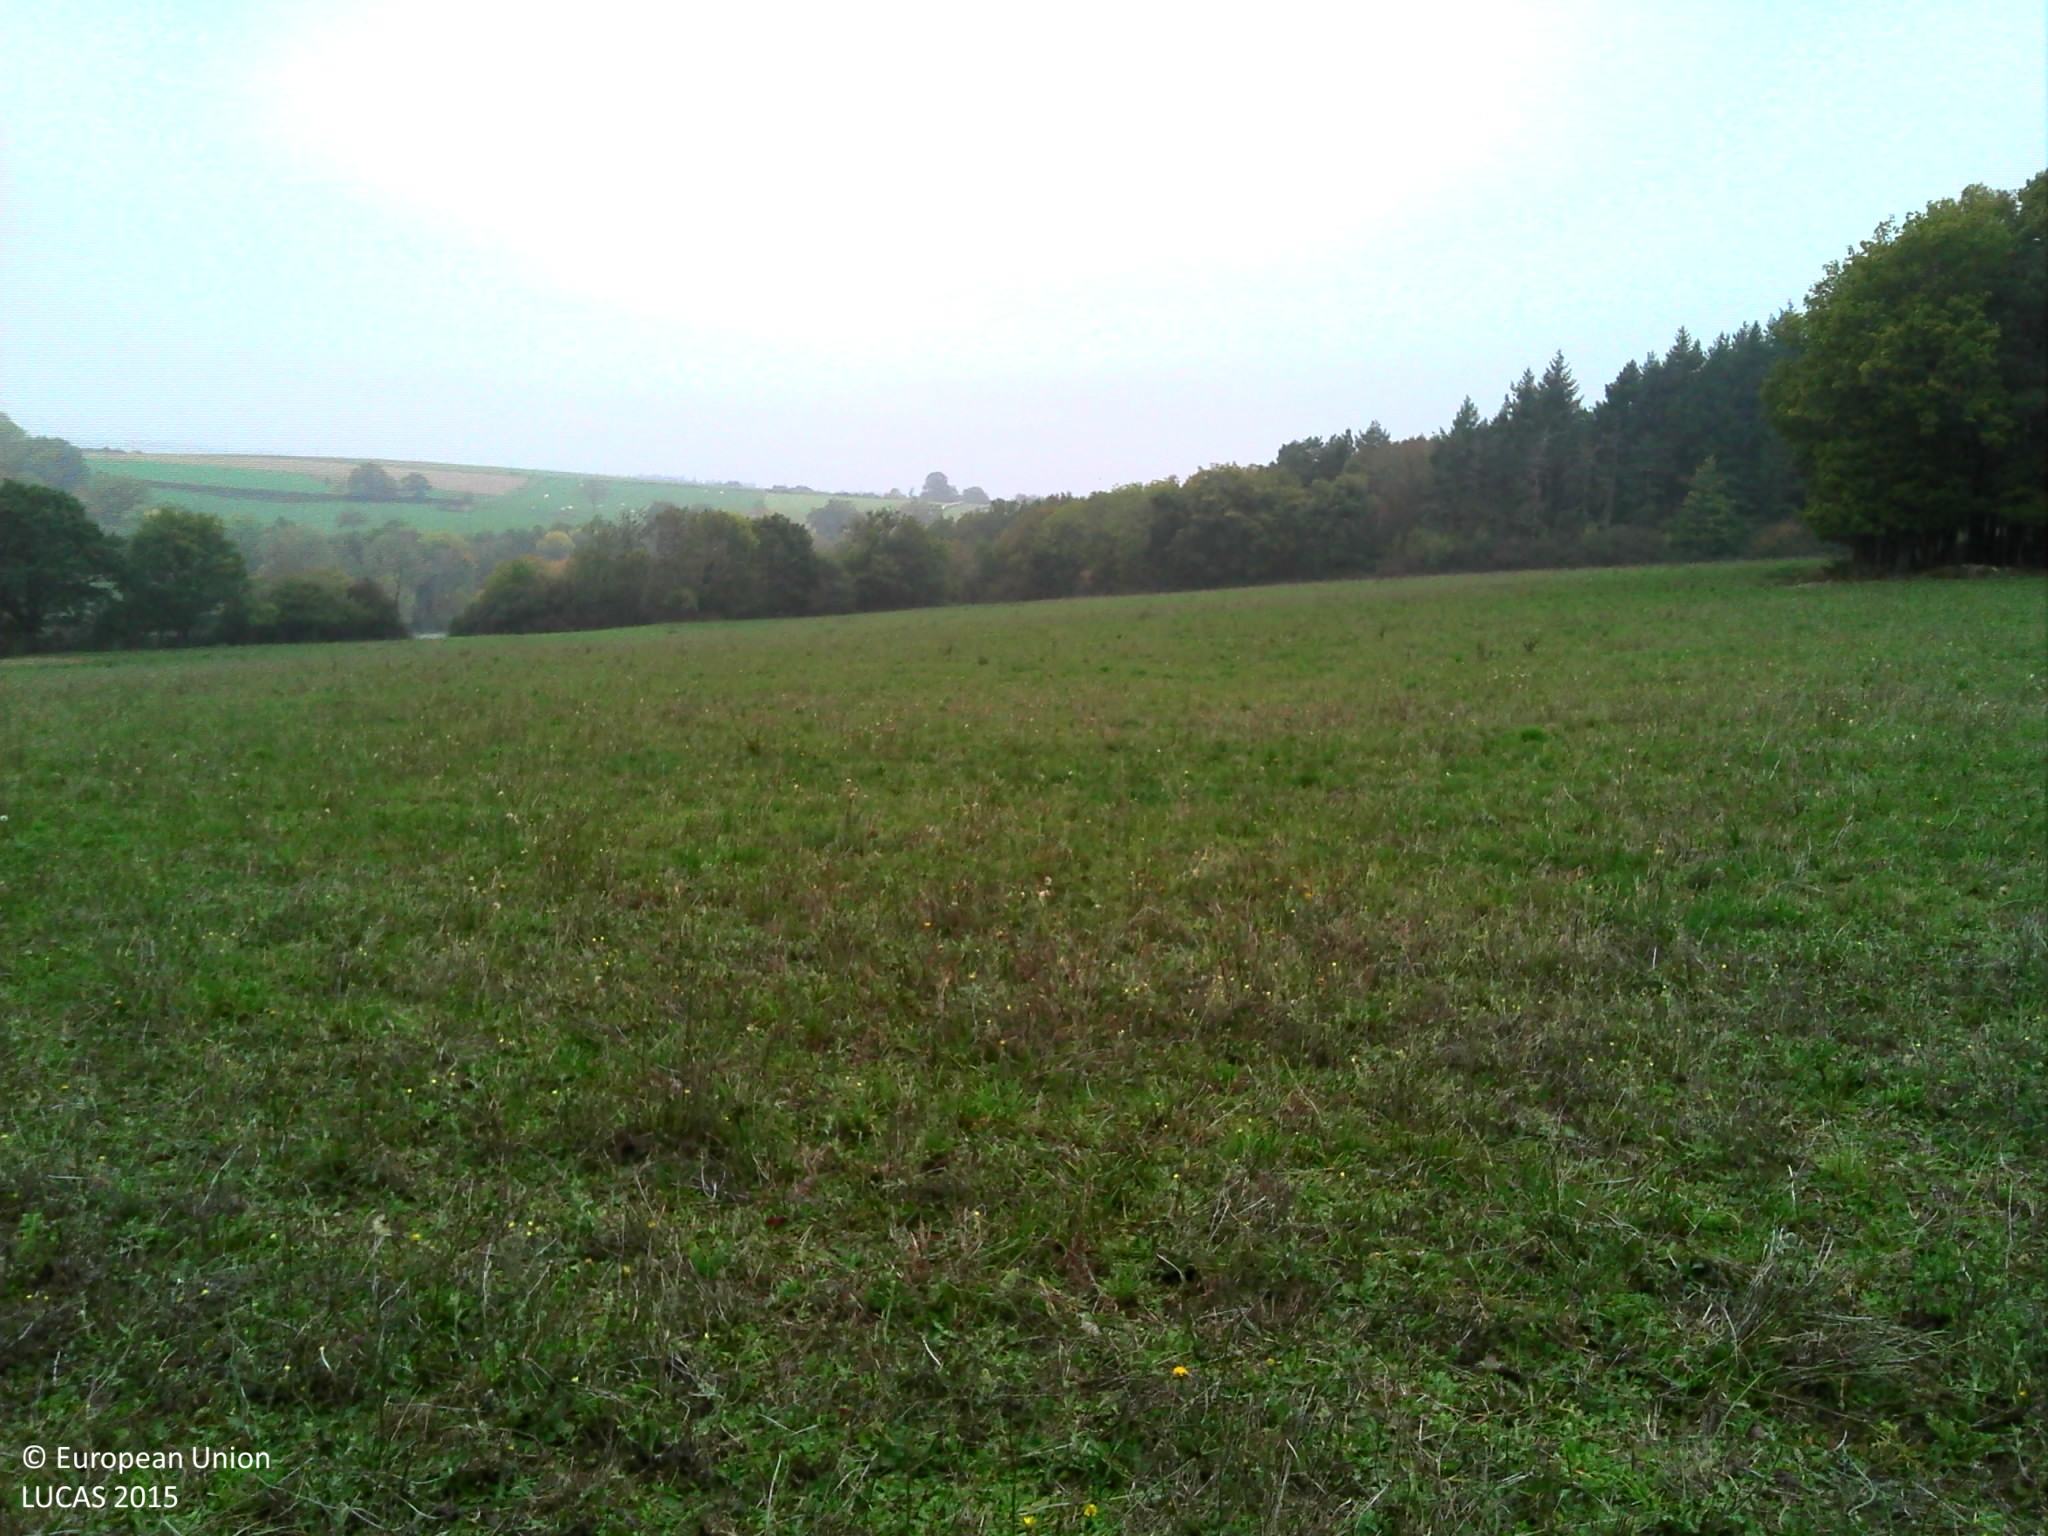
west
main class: Grassland
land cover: Grassland without tree/shrub cover
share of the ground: > 75 %
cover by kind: herbaceous plants 100 %
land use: Agriculture (excluding fallow land and kitchen gardens)
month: October
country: FR
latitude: 46.0516
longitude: 3.0324
